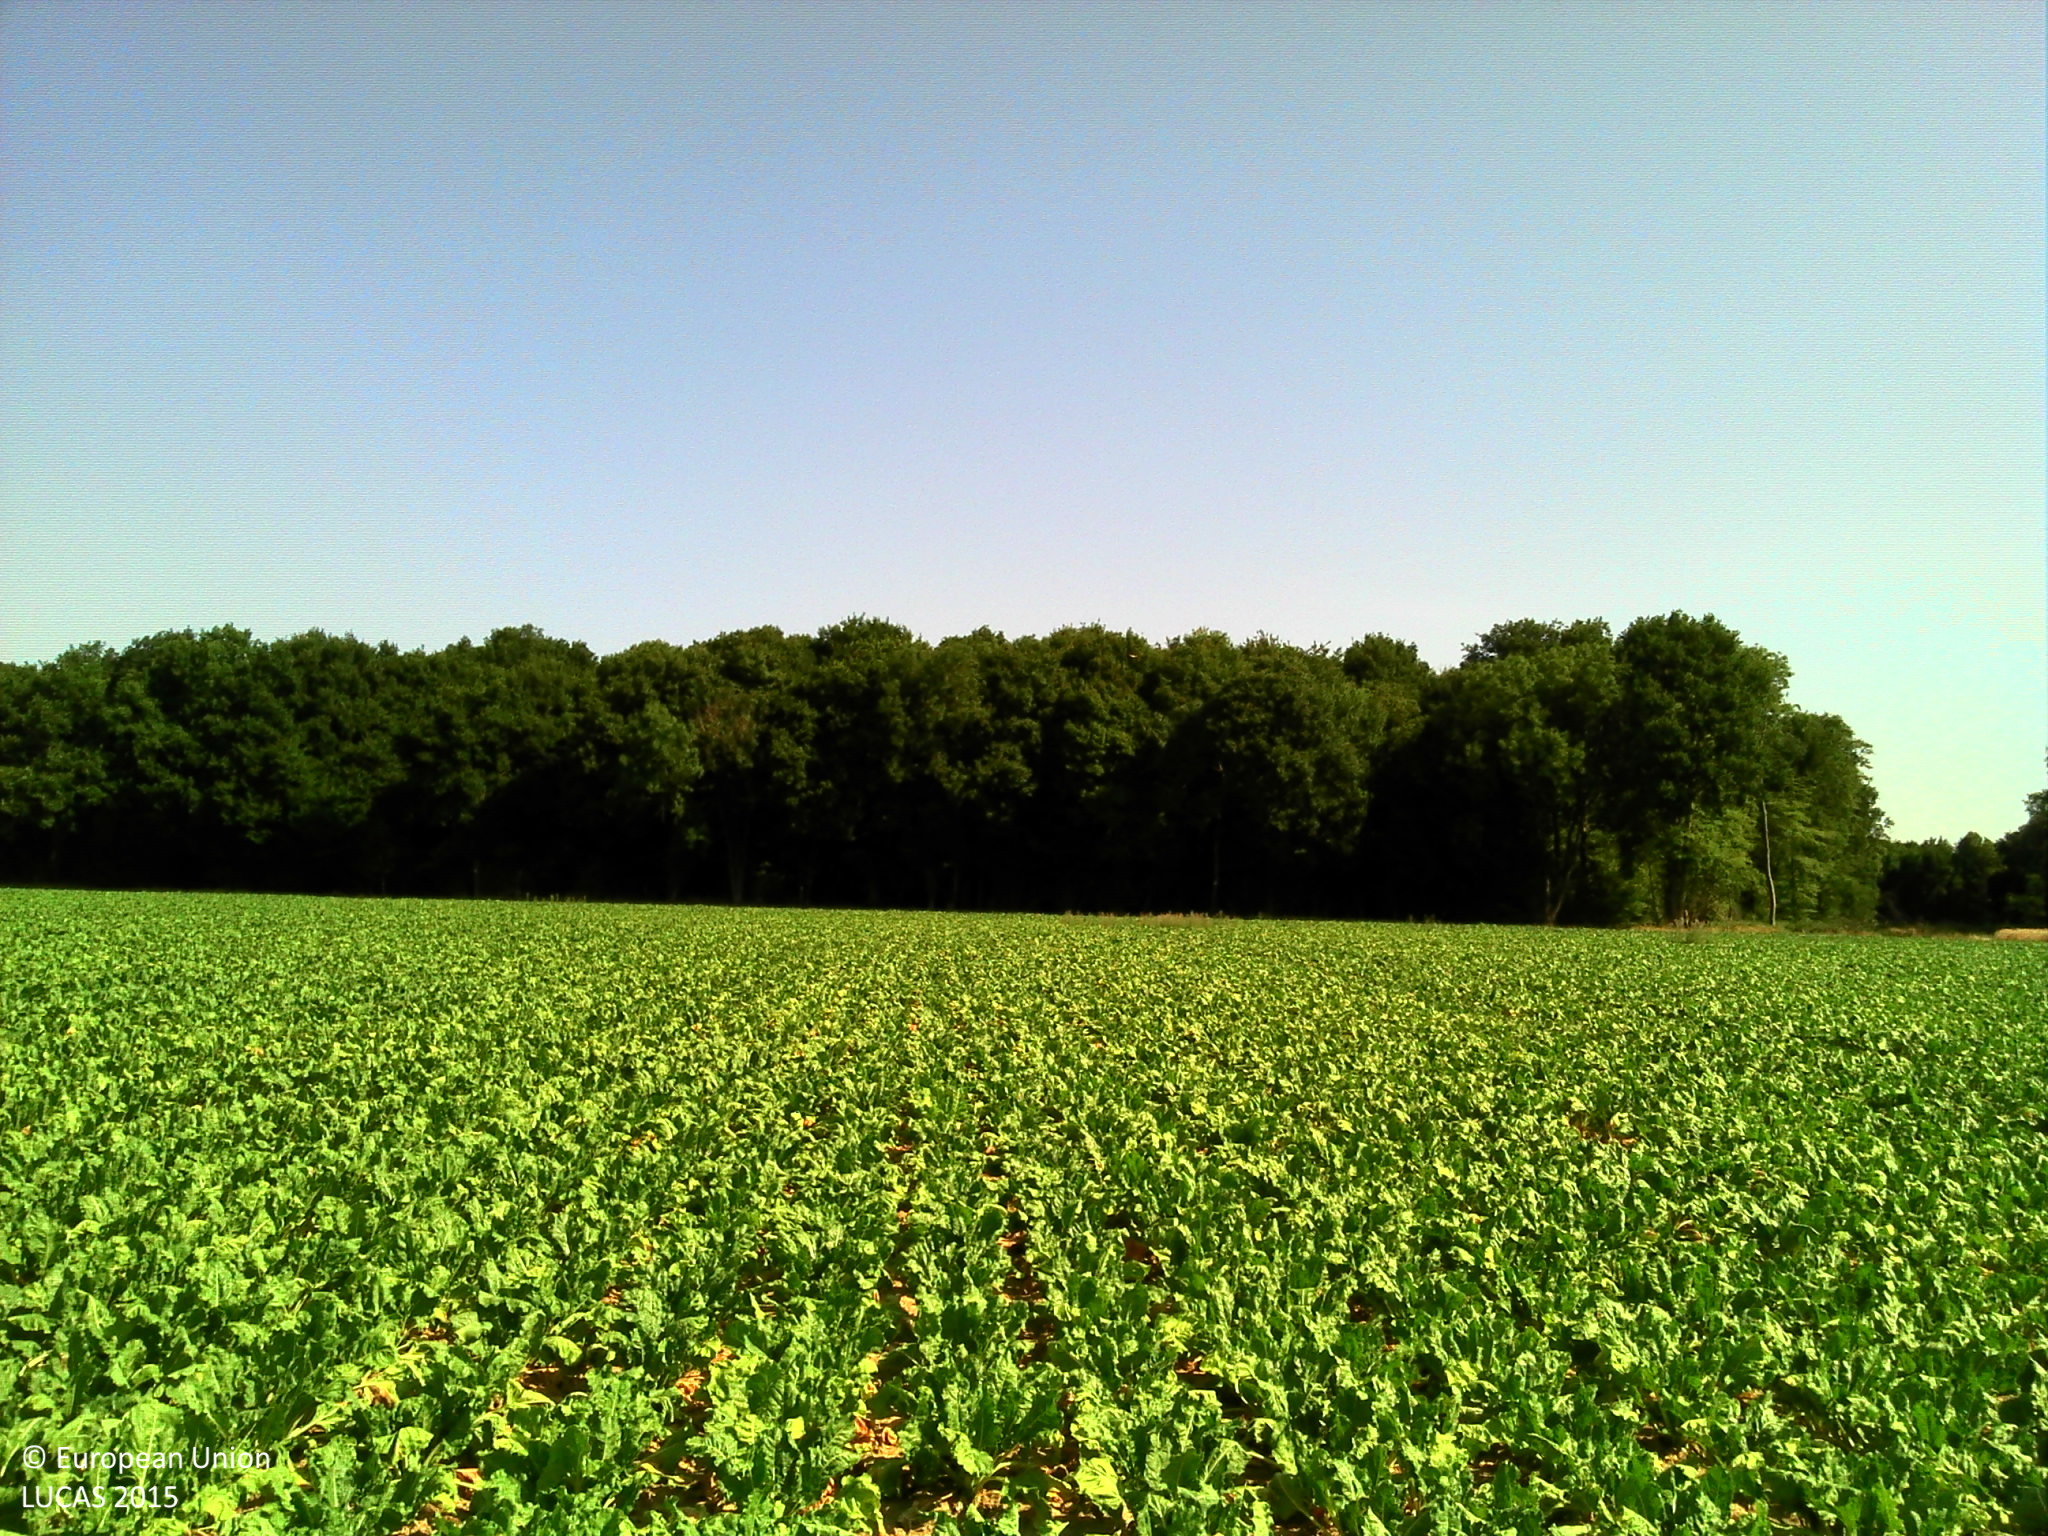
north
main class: Cropland
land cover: Sugar beet
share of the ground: > 75 %
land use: Agriculture (excluding fallow land and kitchen gardens)
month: July
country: FR
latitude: 49.2538
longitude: 2.2794
